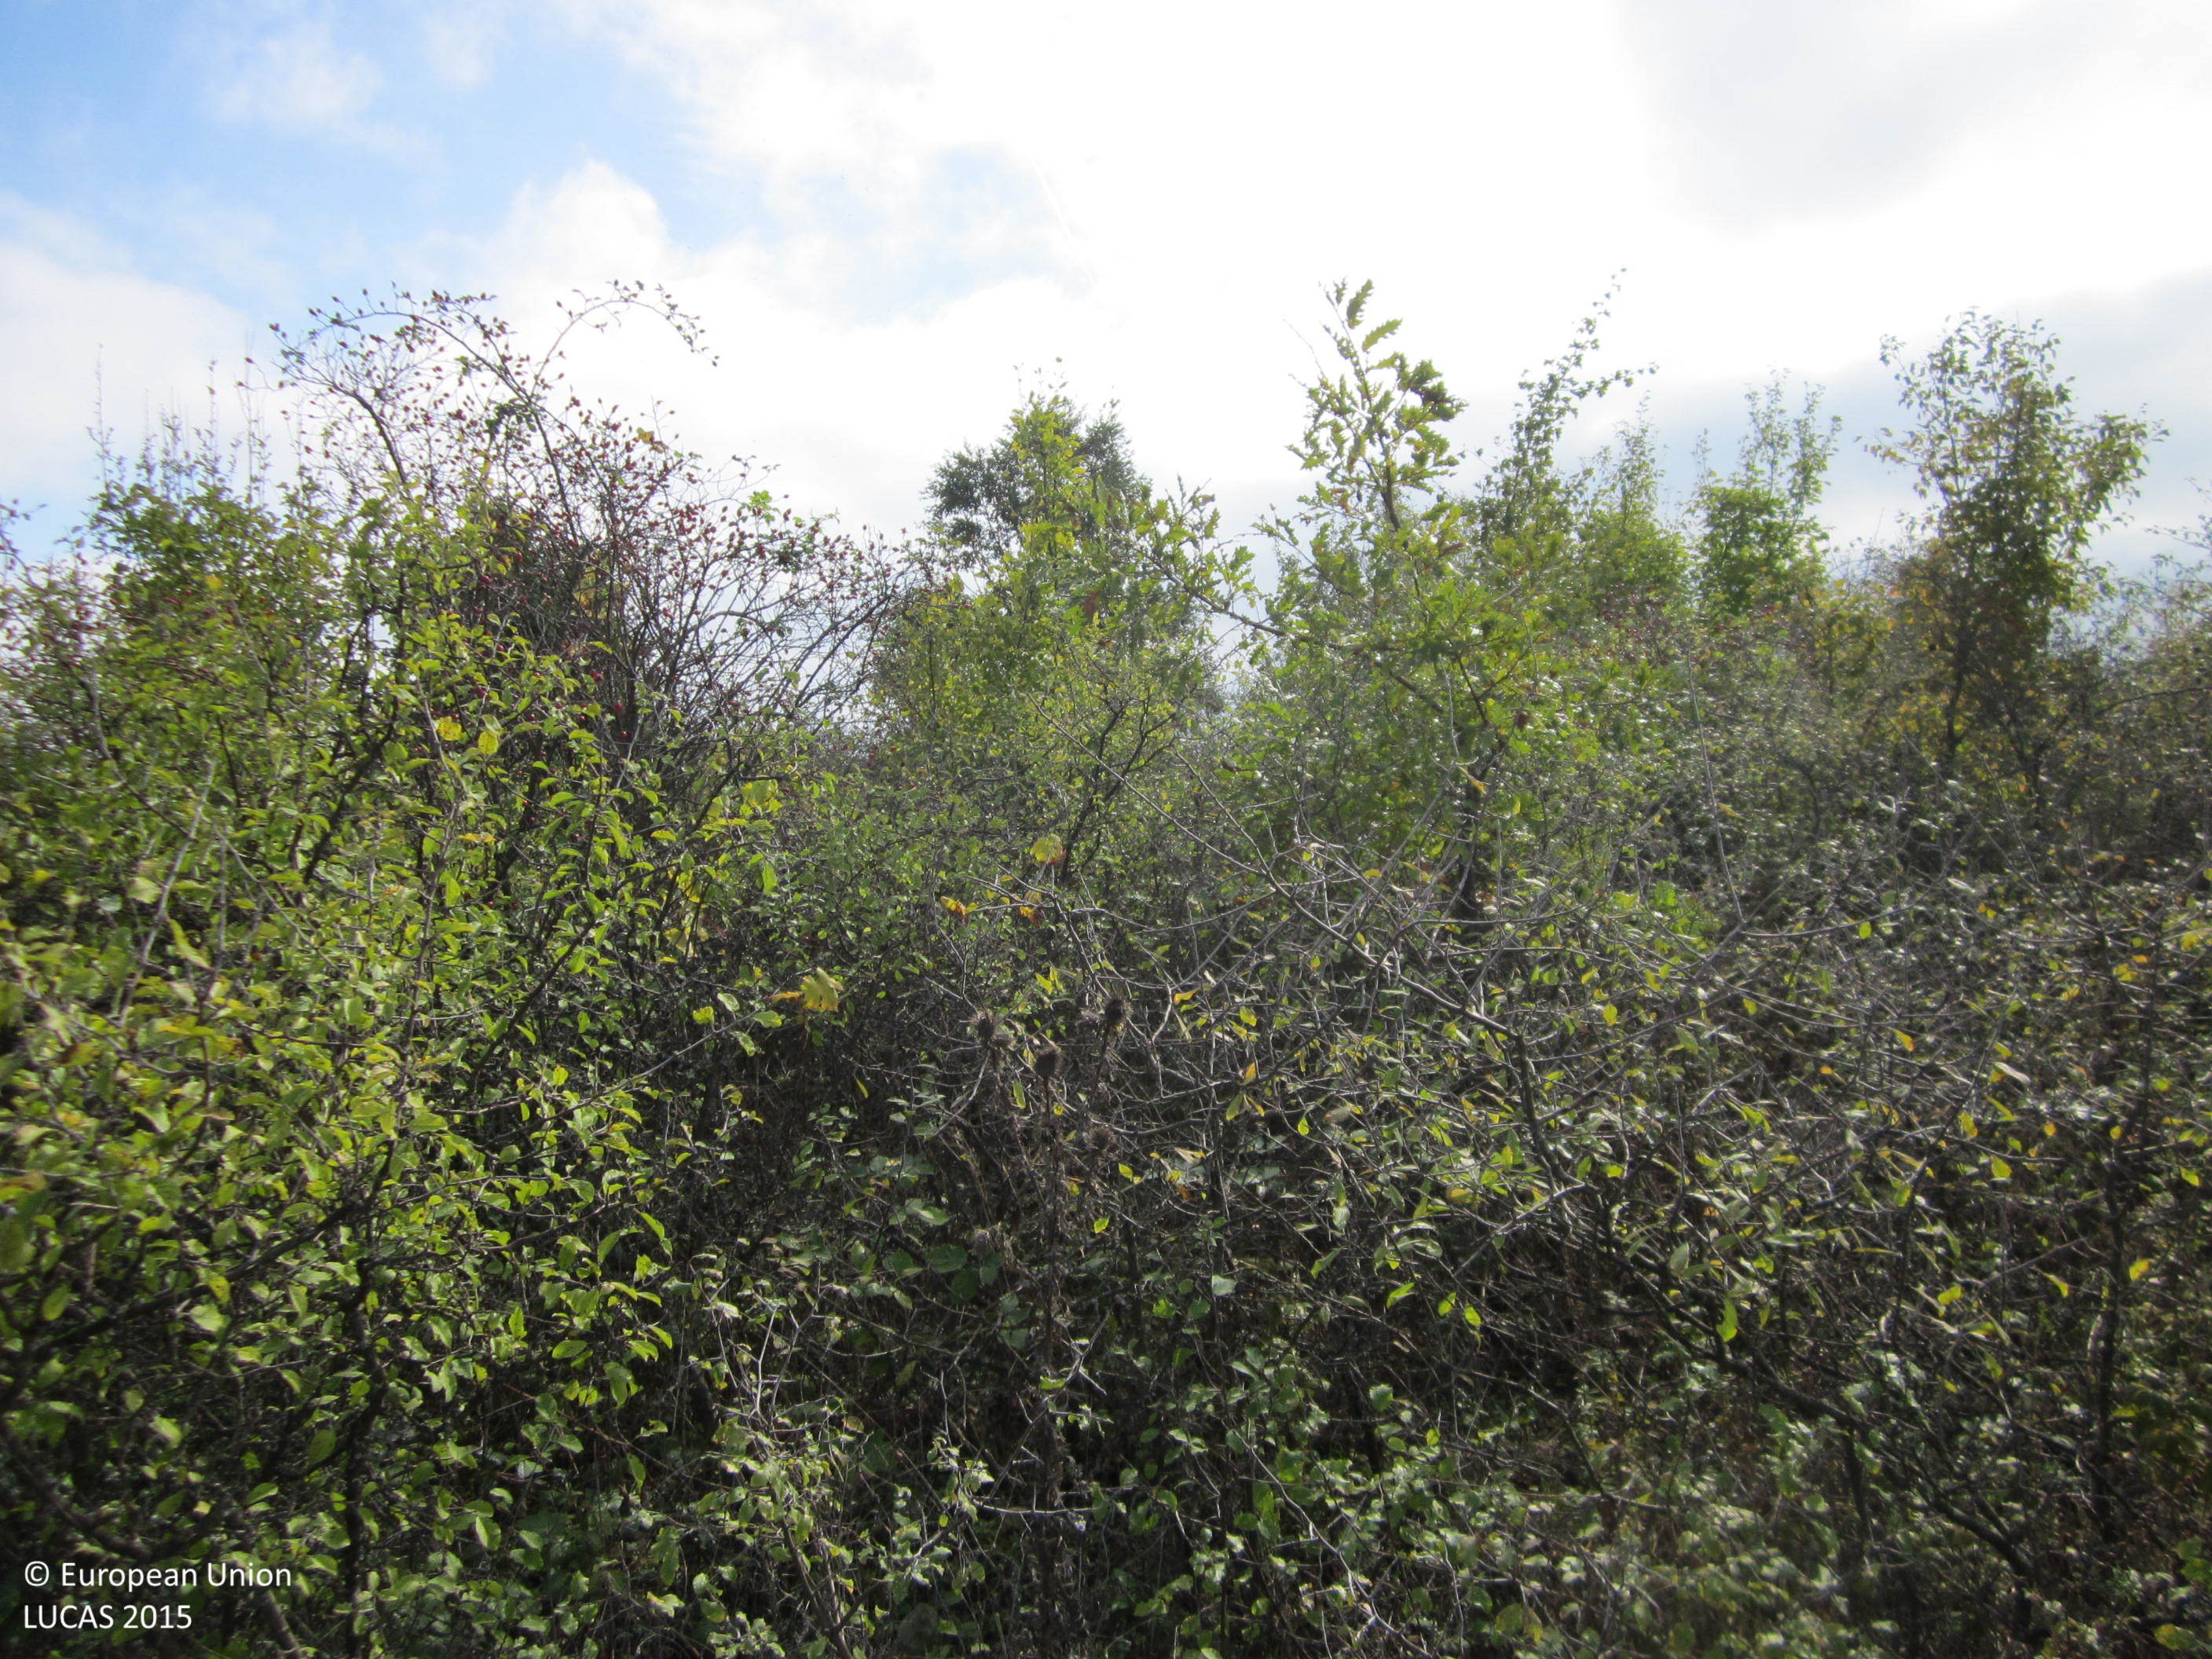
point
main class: Shrubland
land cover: Shrubland with sparse tree cover
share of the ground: > 75 %
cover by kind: shrubs 80 %, herbaceous plants 15 %, broadleaved forest trees 5 %
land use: Semi-natural and natural areas not in use
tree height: < 5 m
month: October
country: BG
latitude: 42.3291
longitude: 27.2066
